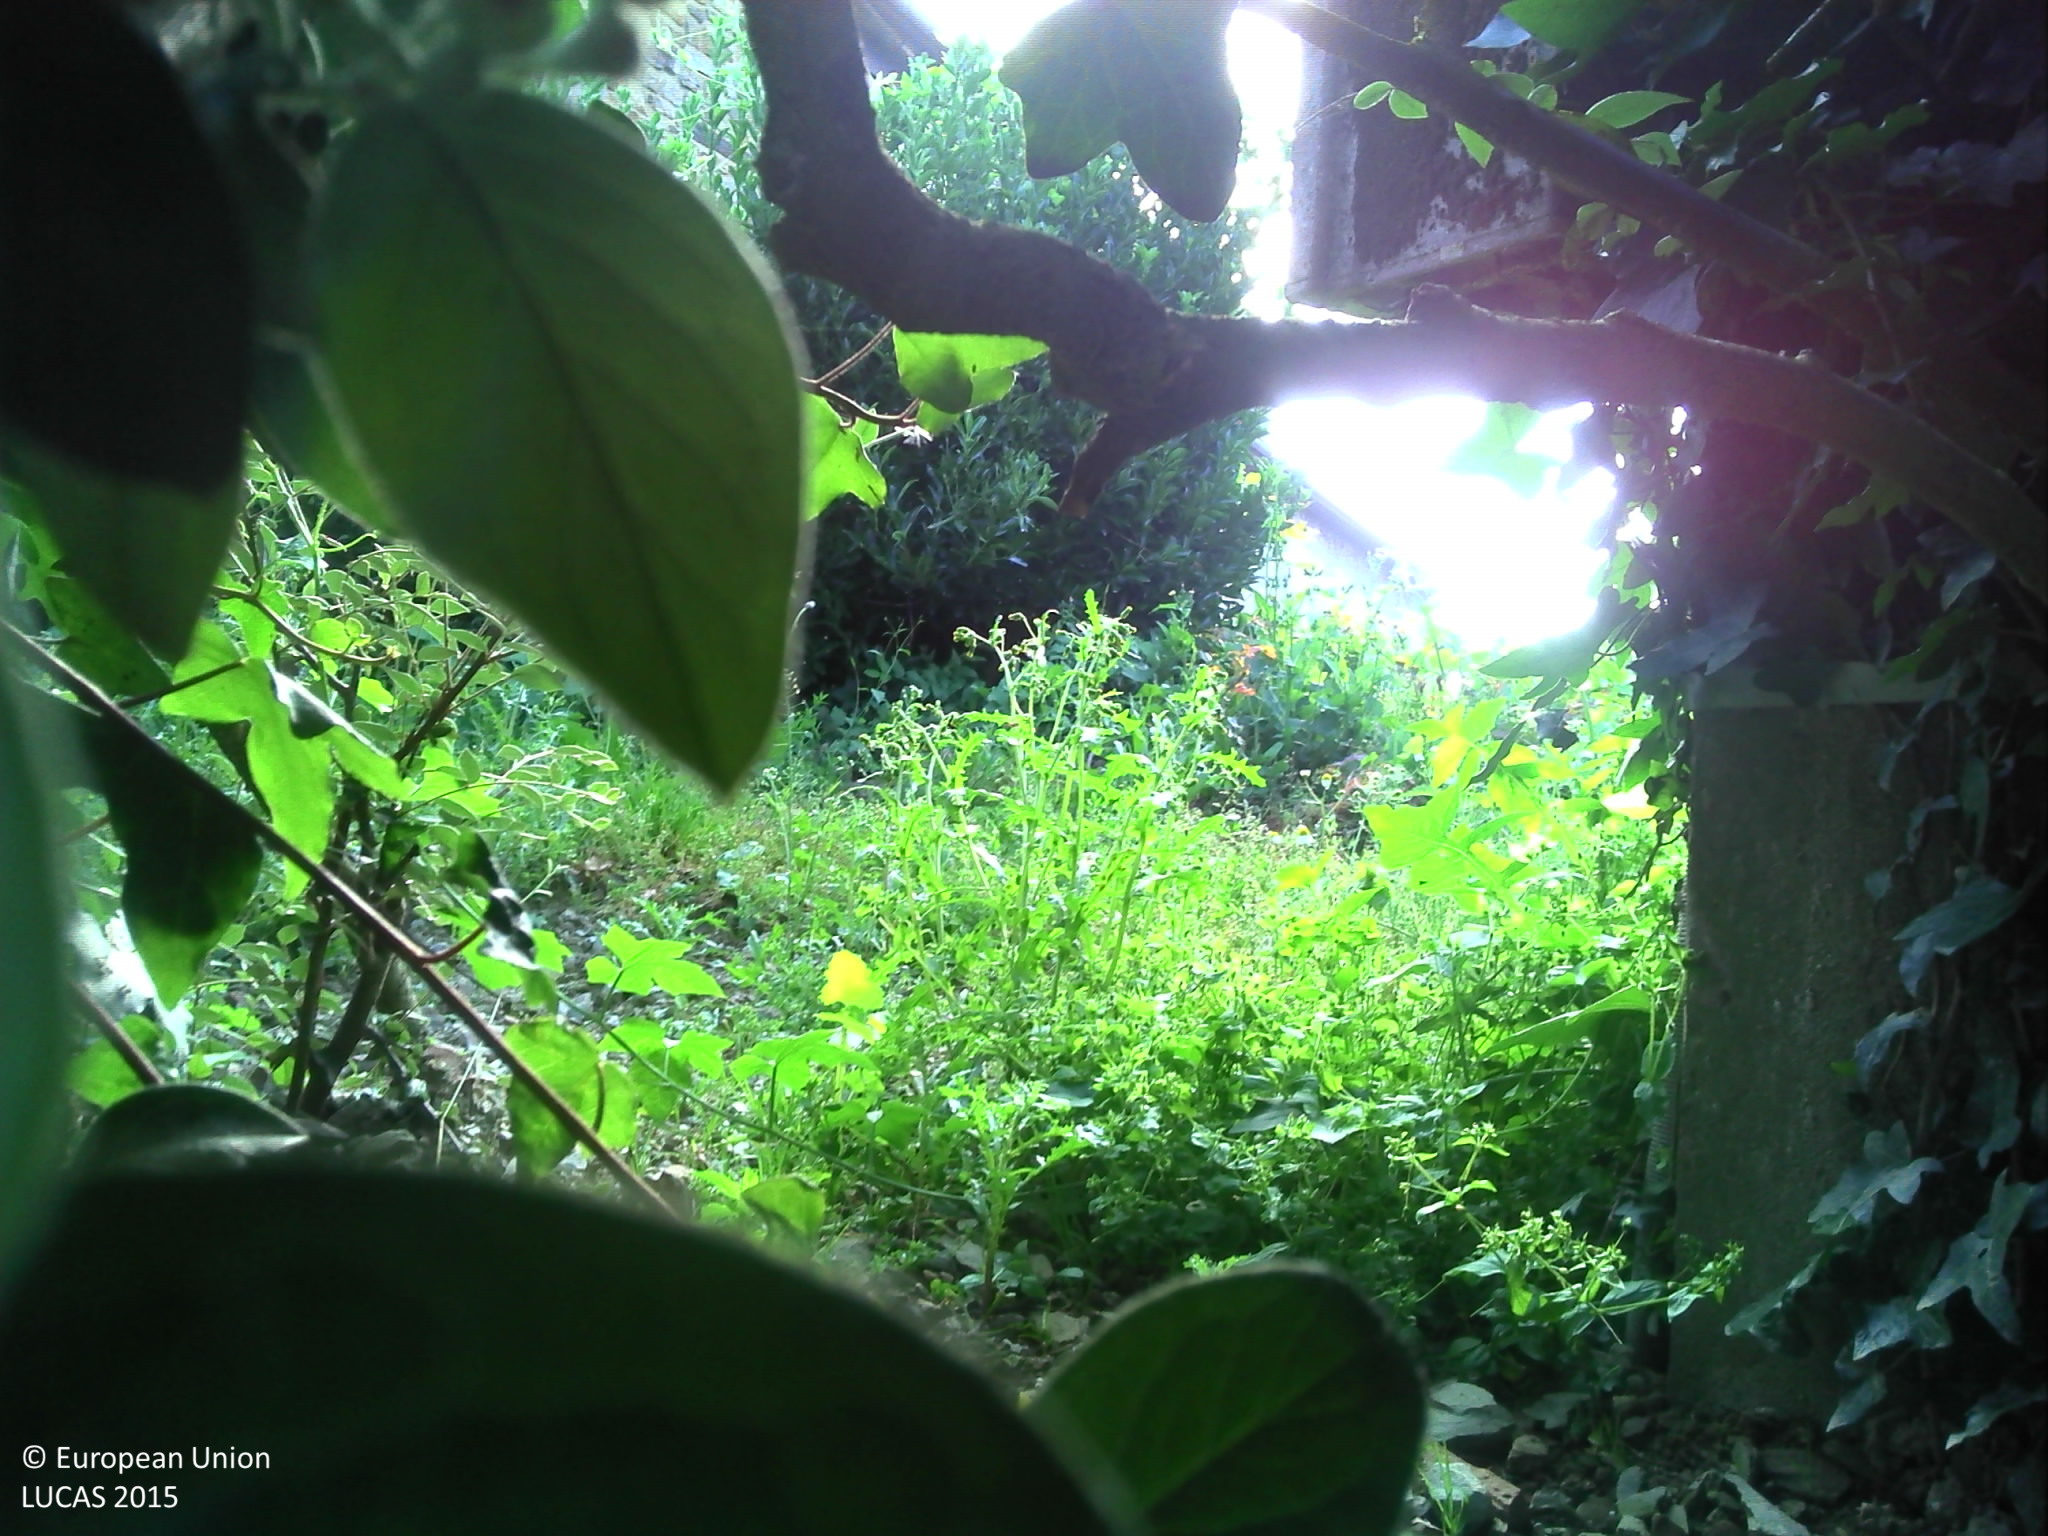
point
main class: Grassland
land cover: Grassland with sparse tree/shrub cover
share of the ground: > 75 %
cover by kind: herbaceous plants 95 %, broadleaved forest trees 5 %
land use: Residential
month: June
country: FR
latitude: 48.0268
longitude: -1.4290
